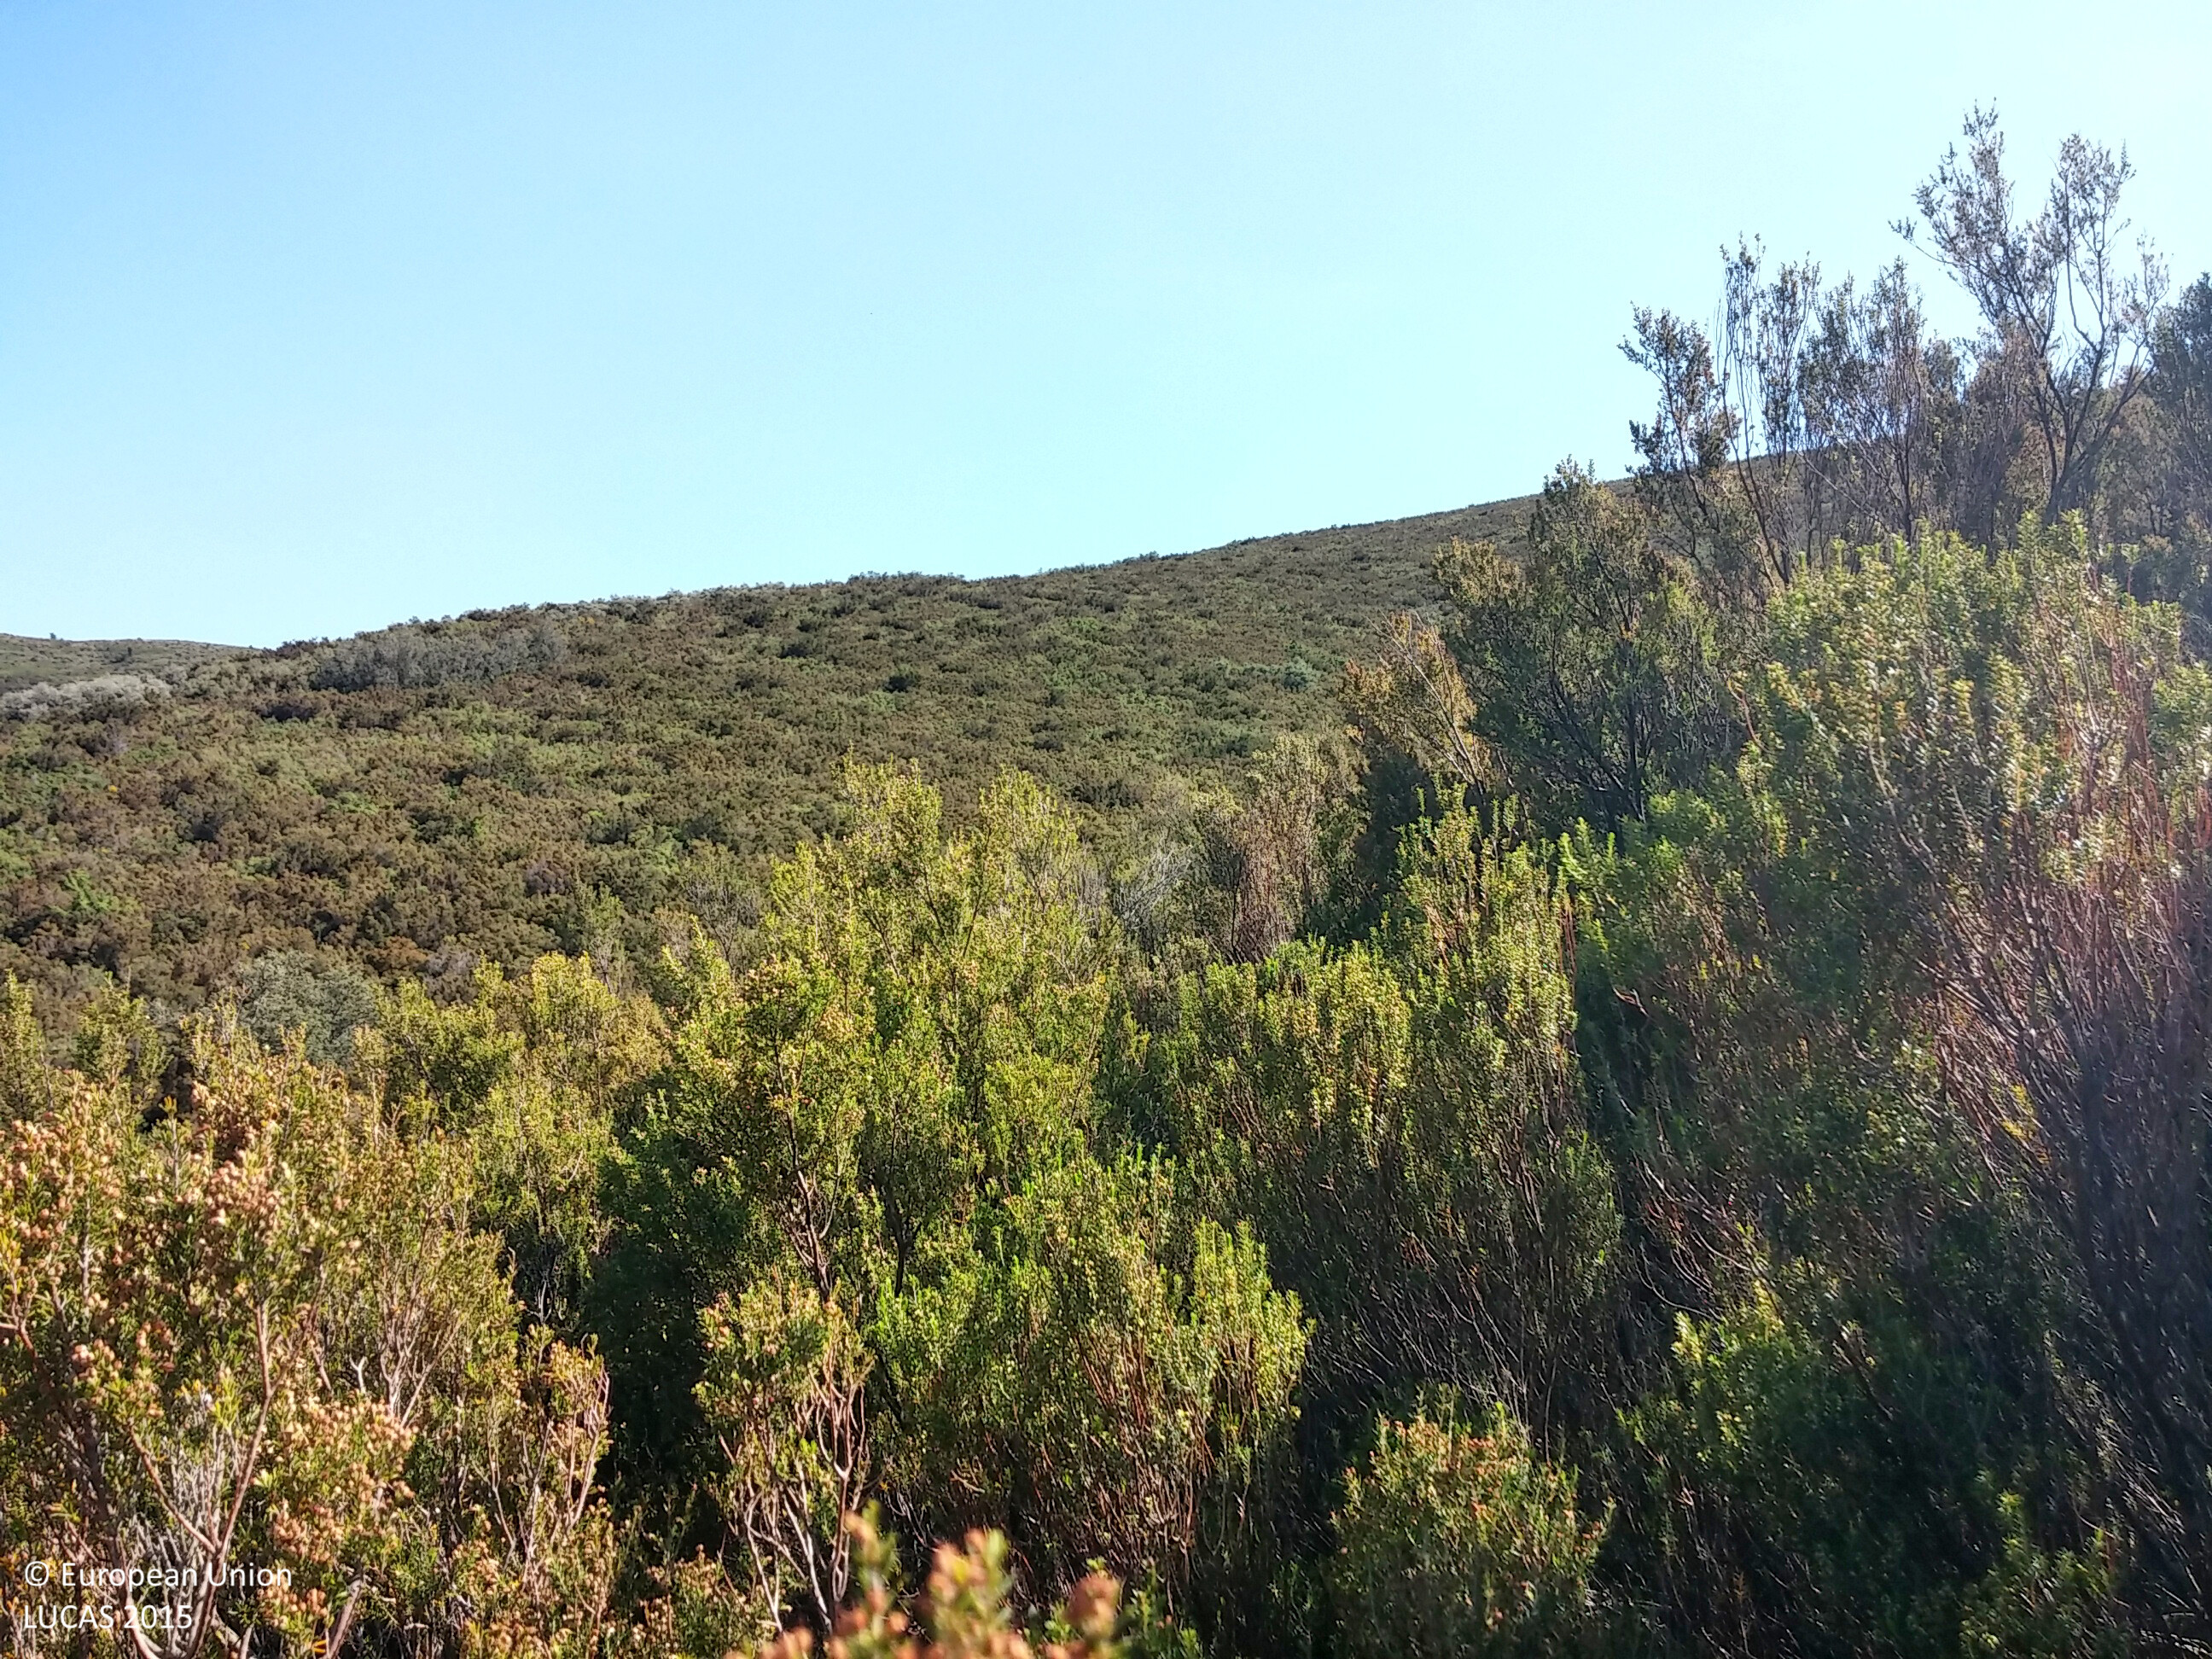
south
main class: Shrubland
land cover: Shrubland without tree cover
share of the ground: > 75 %
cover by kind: shrubs 100 %
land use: Semi-natural and natural areas not in use
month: May
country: ES
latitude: 42.4331
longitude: 3.0483
